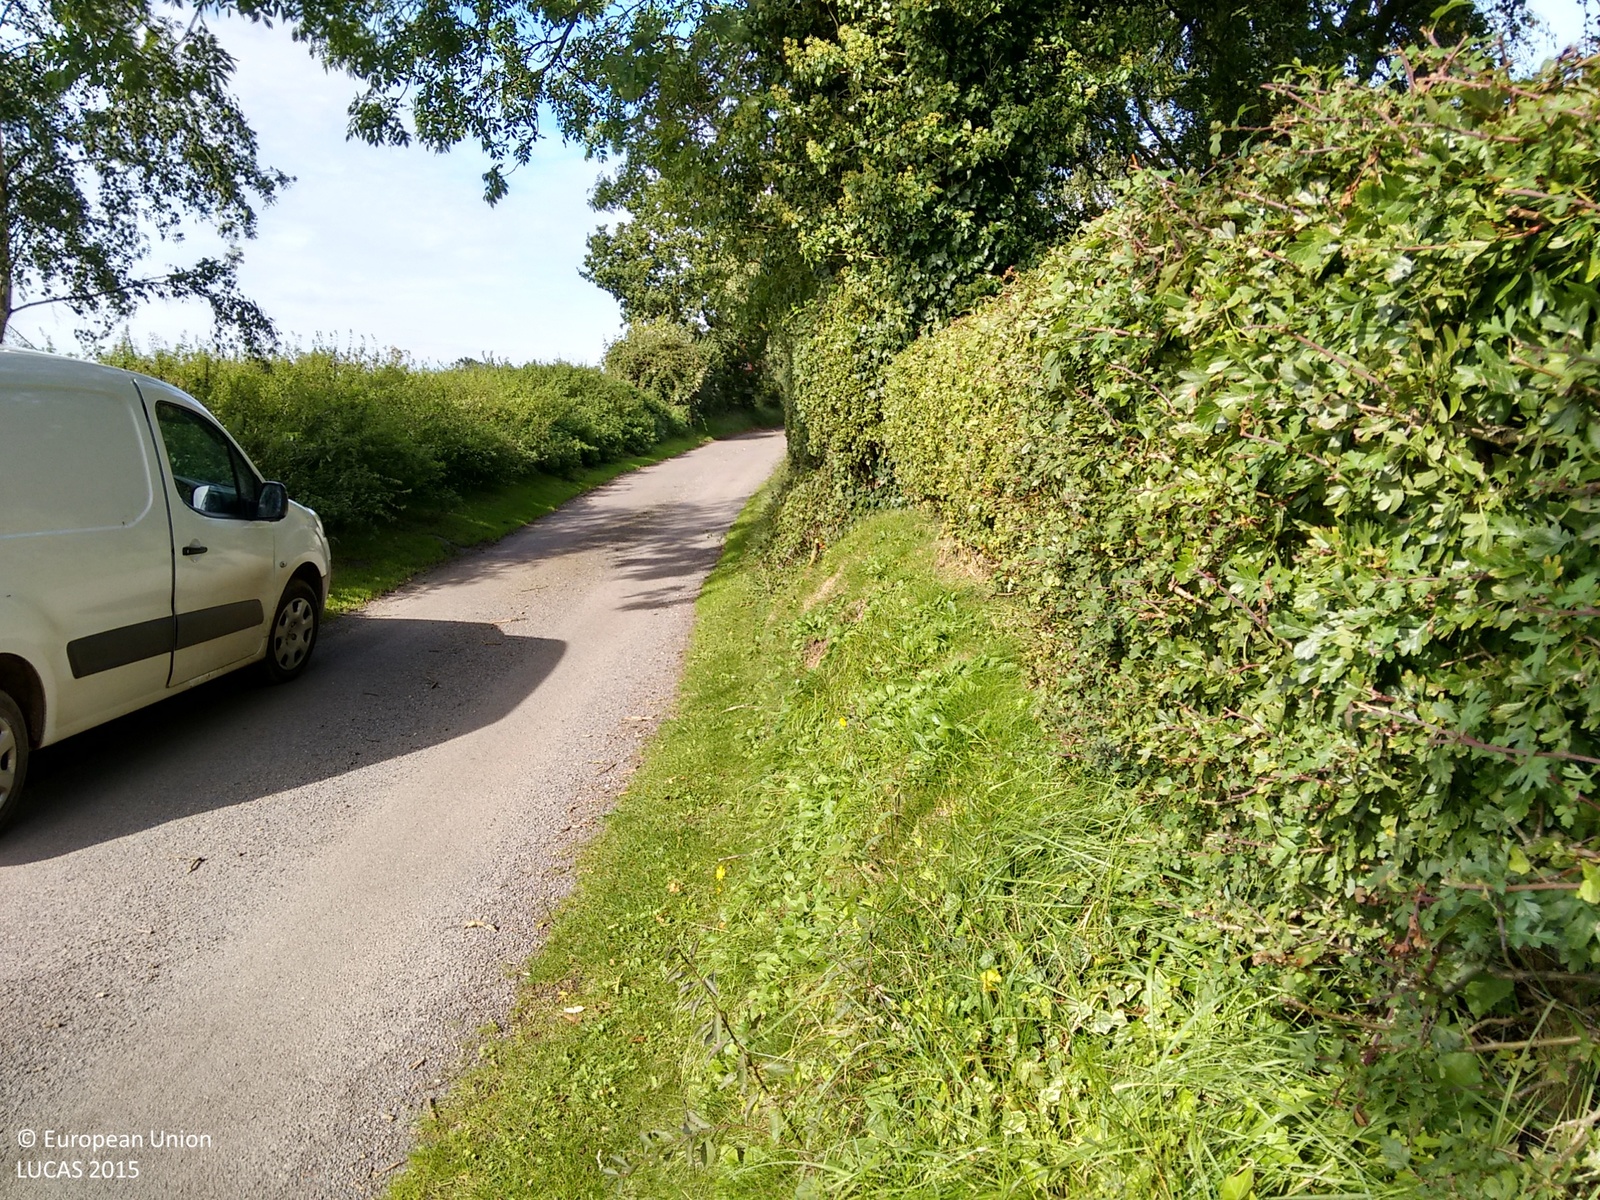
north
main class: Grassland
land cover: Grassland with sparse tree/shrub cover
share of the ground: > 75 %
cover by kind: herbaceous plants 95 %, broadleaved forest trees 5 %
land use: Residential
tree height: > 5 m
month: September
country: GB
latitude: 52.8506
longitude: 1.2628
